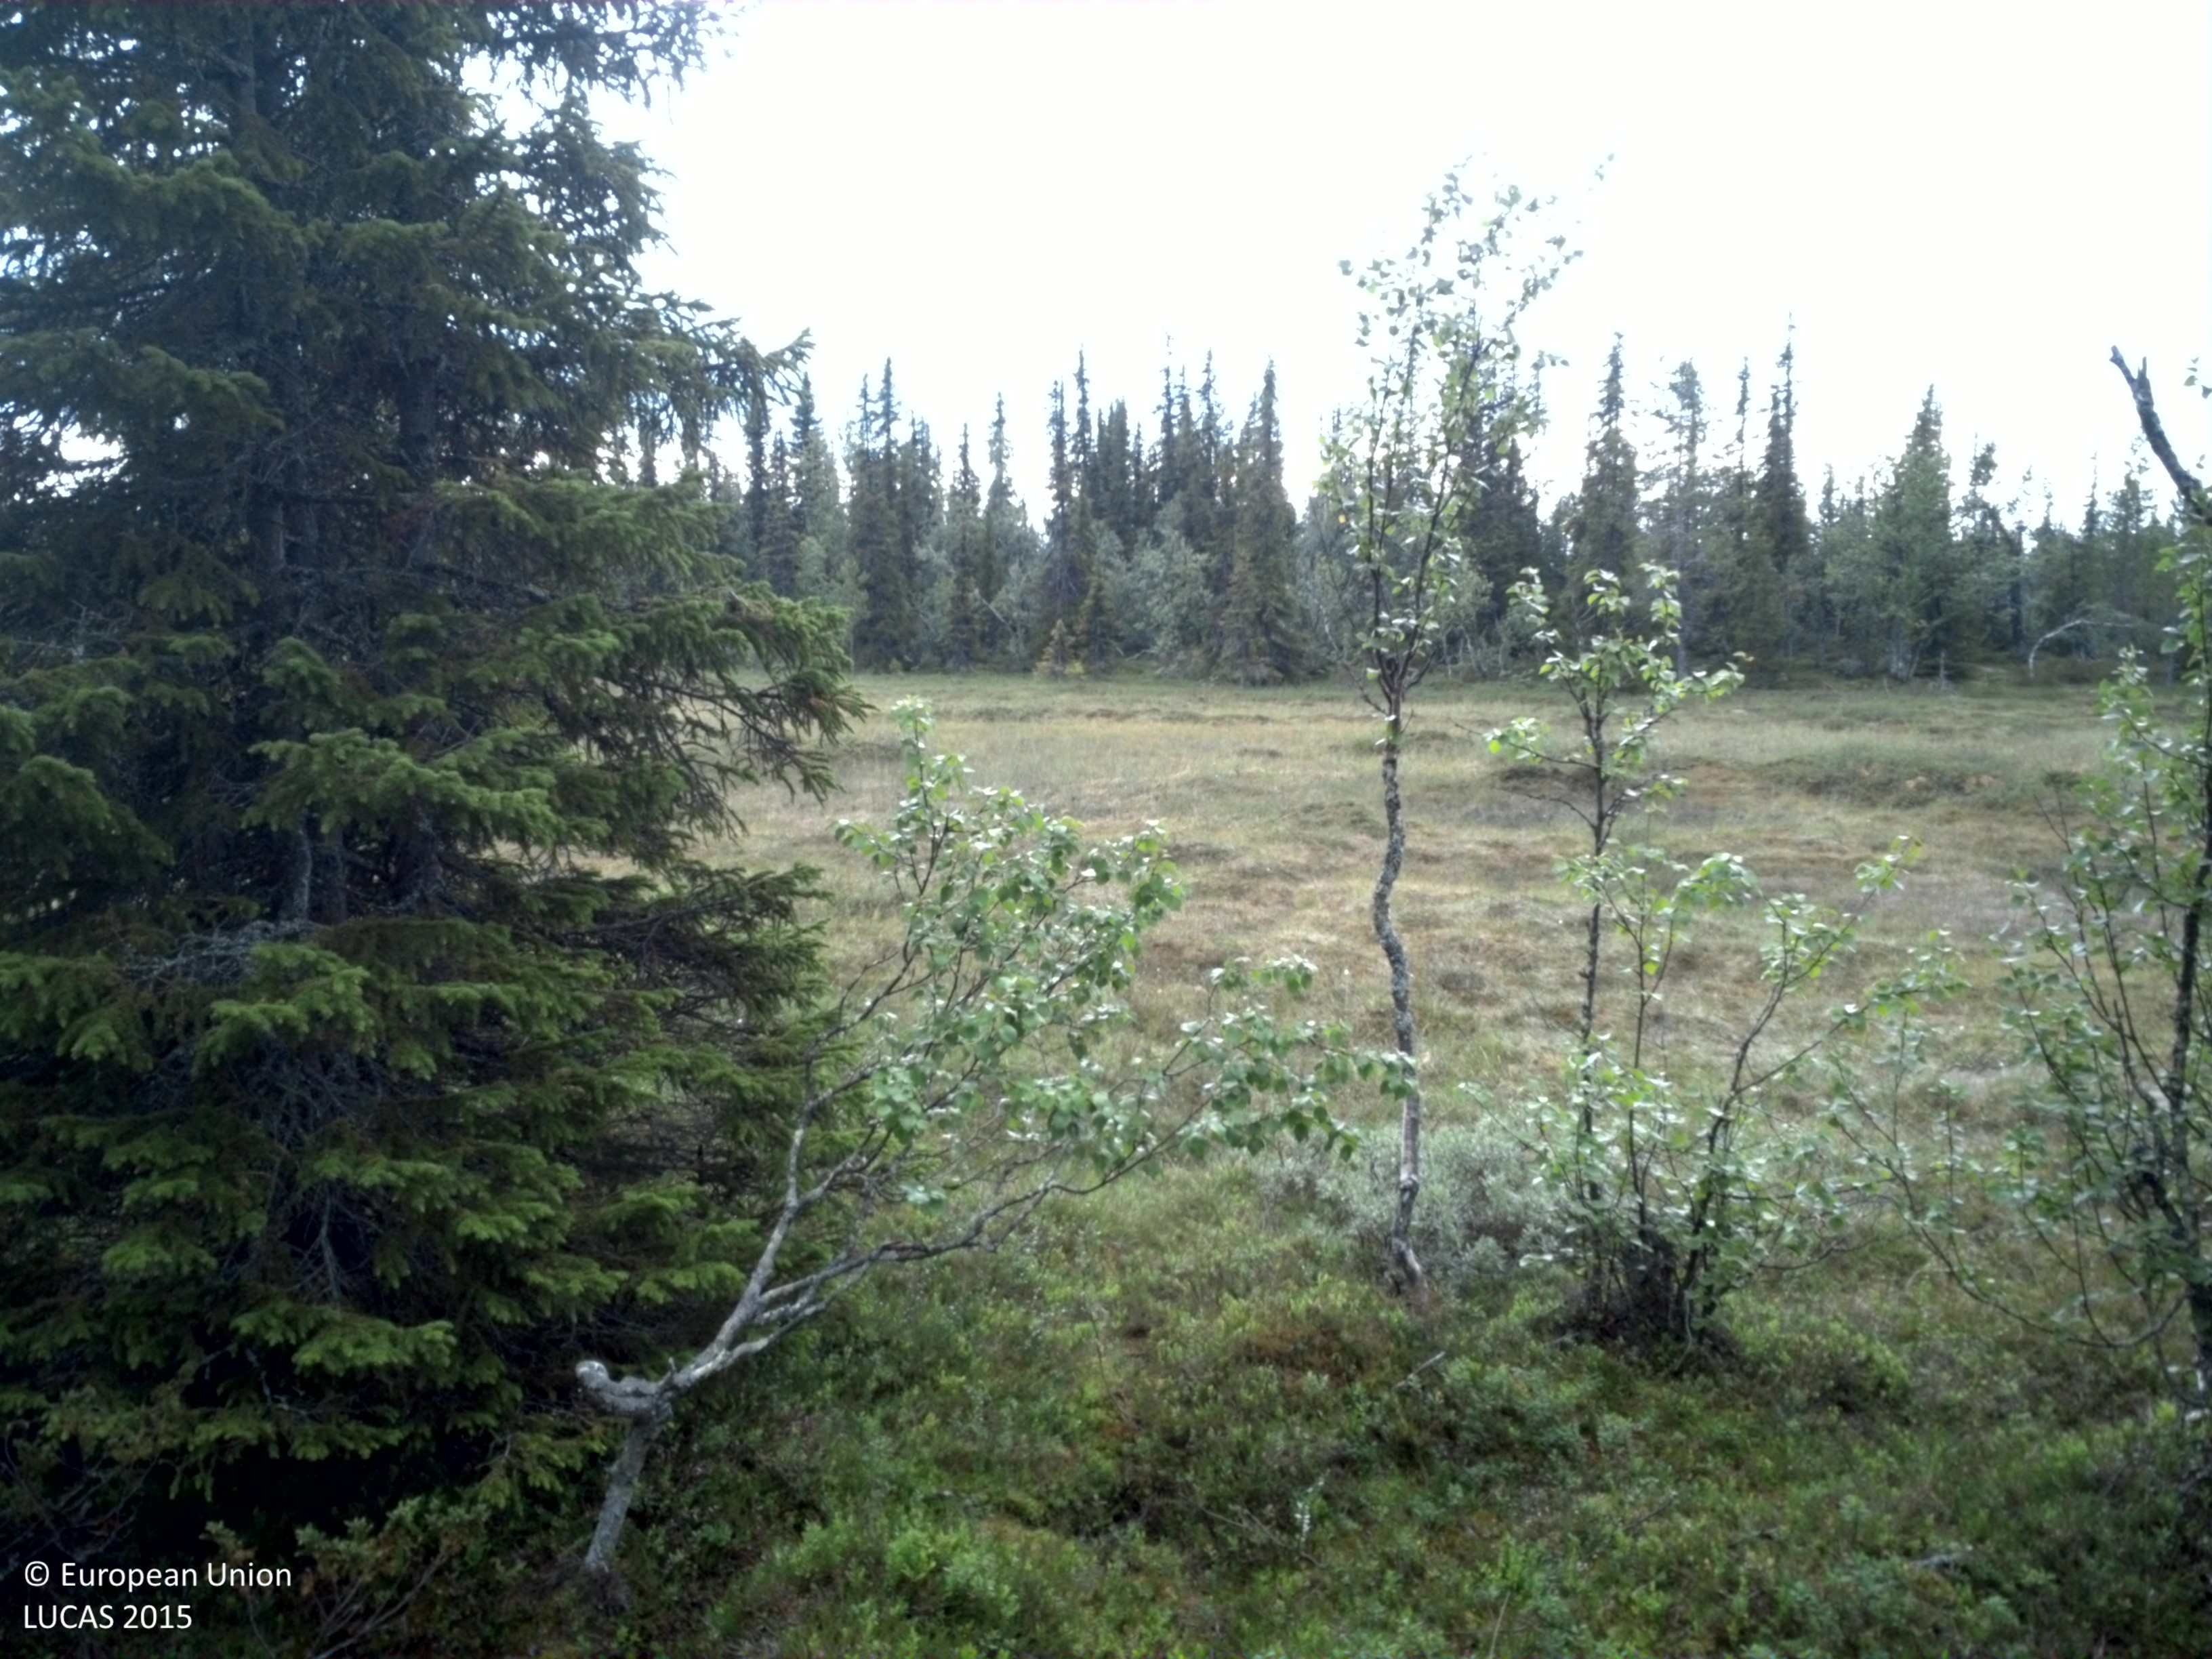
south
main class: Woodland
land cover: Spruce dominated mixed woodland
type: boreal forest
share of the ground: 25 - 50 %
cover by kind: shrubs 55 %, lichens and mosses 20 %, broadleaved forest trees 15 %, coniferous forest trees 10 %
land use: Semi-natural and natural areas not in use
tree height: > 5 m
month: August
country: SE
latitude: 65.0075
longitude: 15.5461
